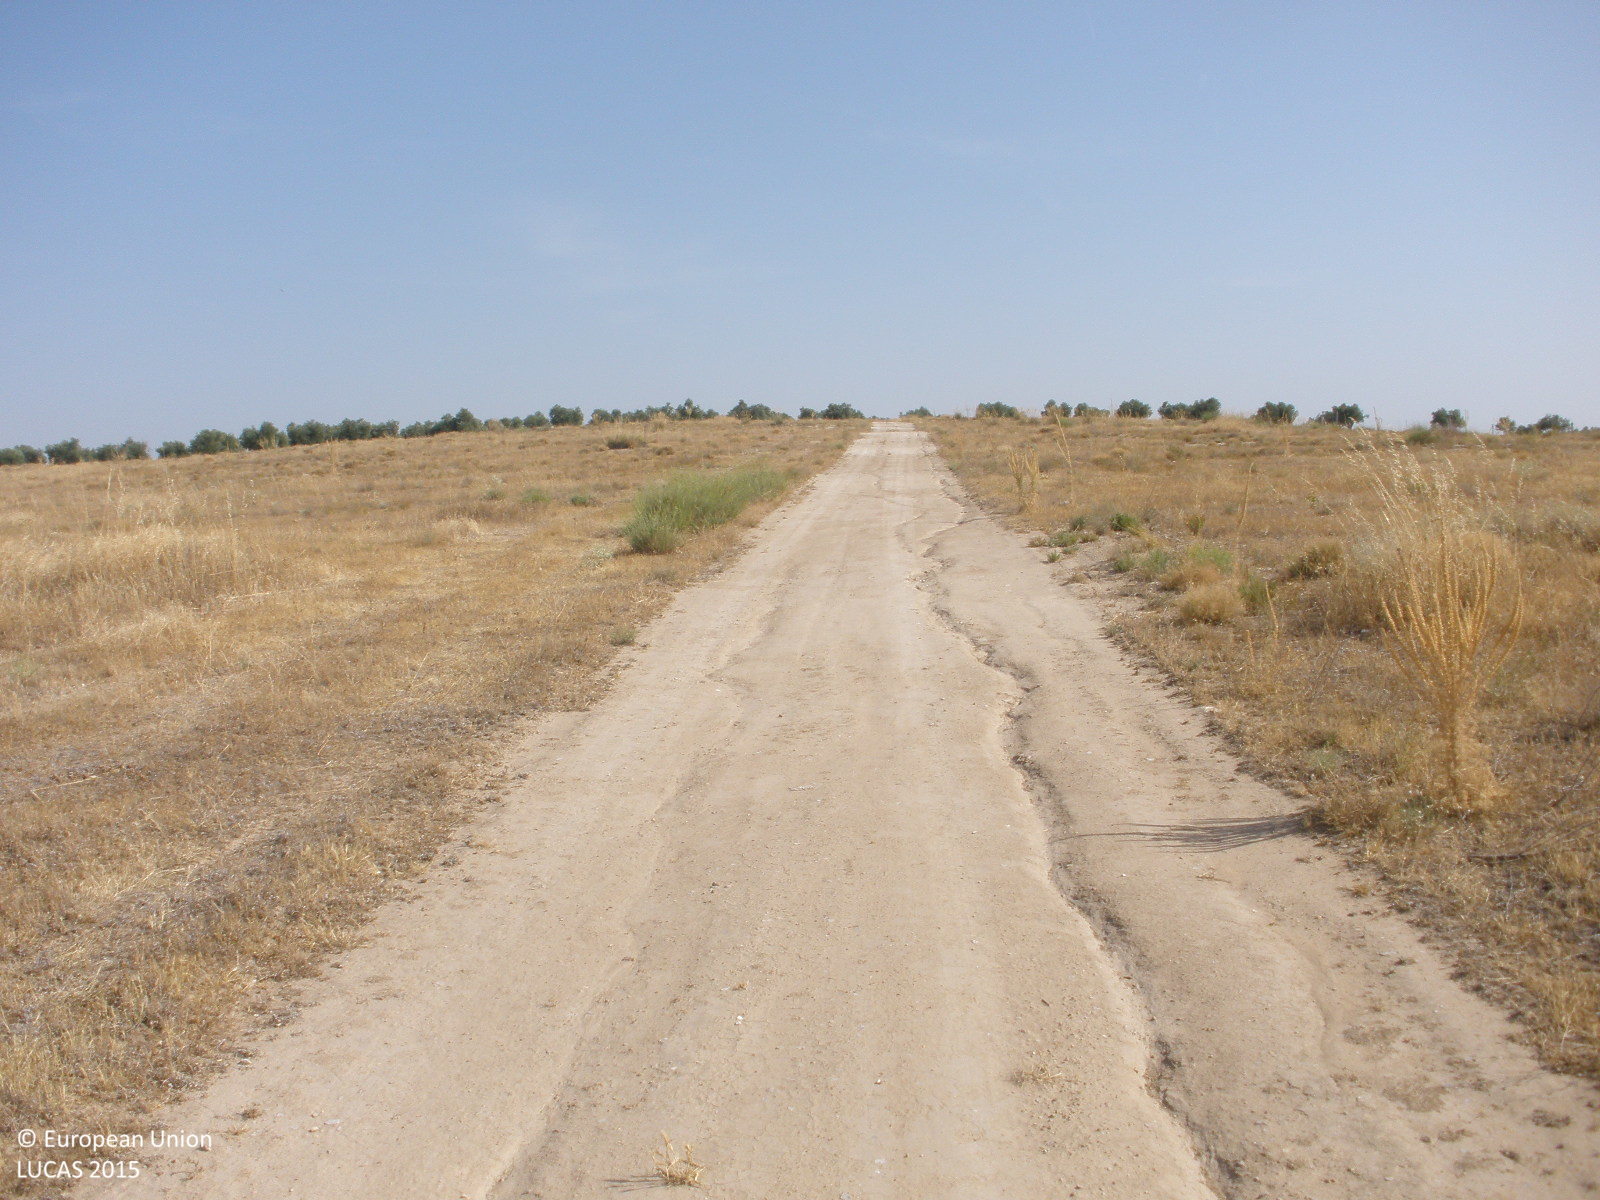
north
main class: Shrubland
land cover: Shrubland without tree cover
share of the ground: 25 - 50 %
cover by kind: herbaceous plants 50 %, shrubs 30 %, consolidated bare surface 20 %
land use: Semi-natural and natural areas not in use
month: July
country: ES
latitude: 40.0976
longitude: -3.5086
